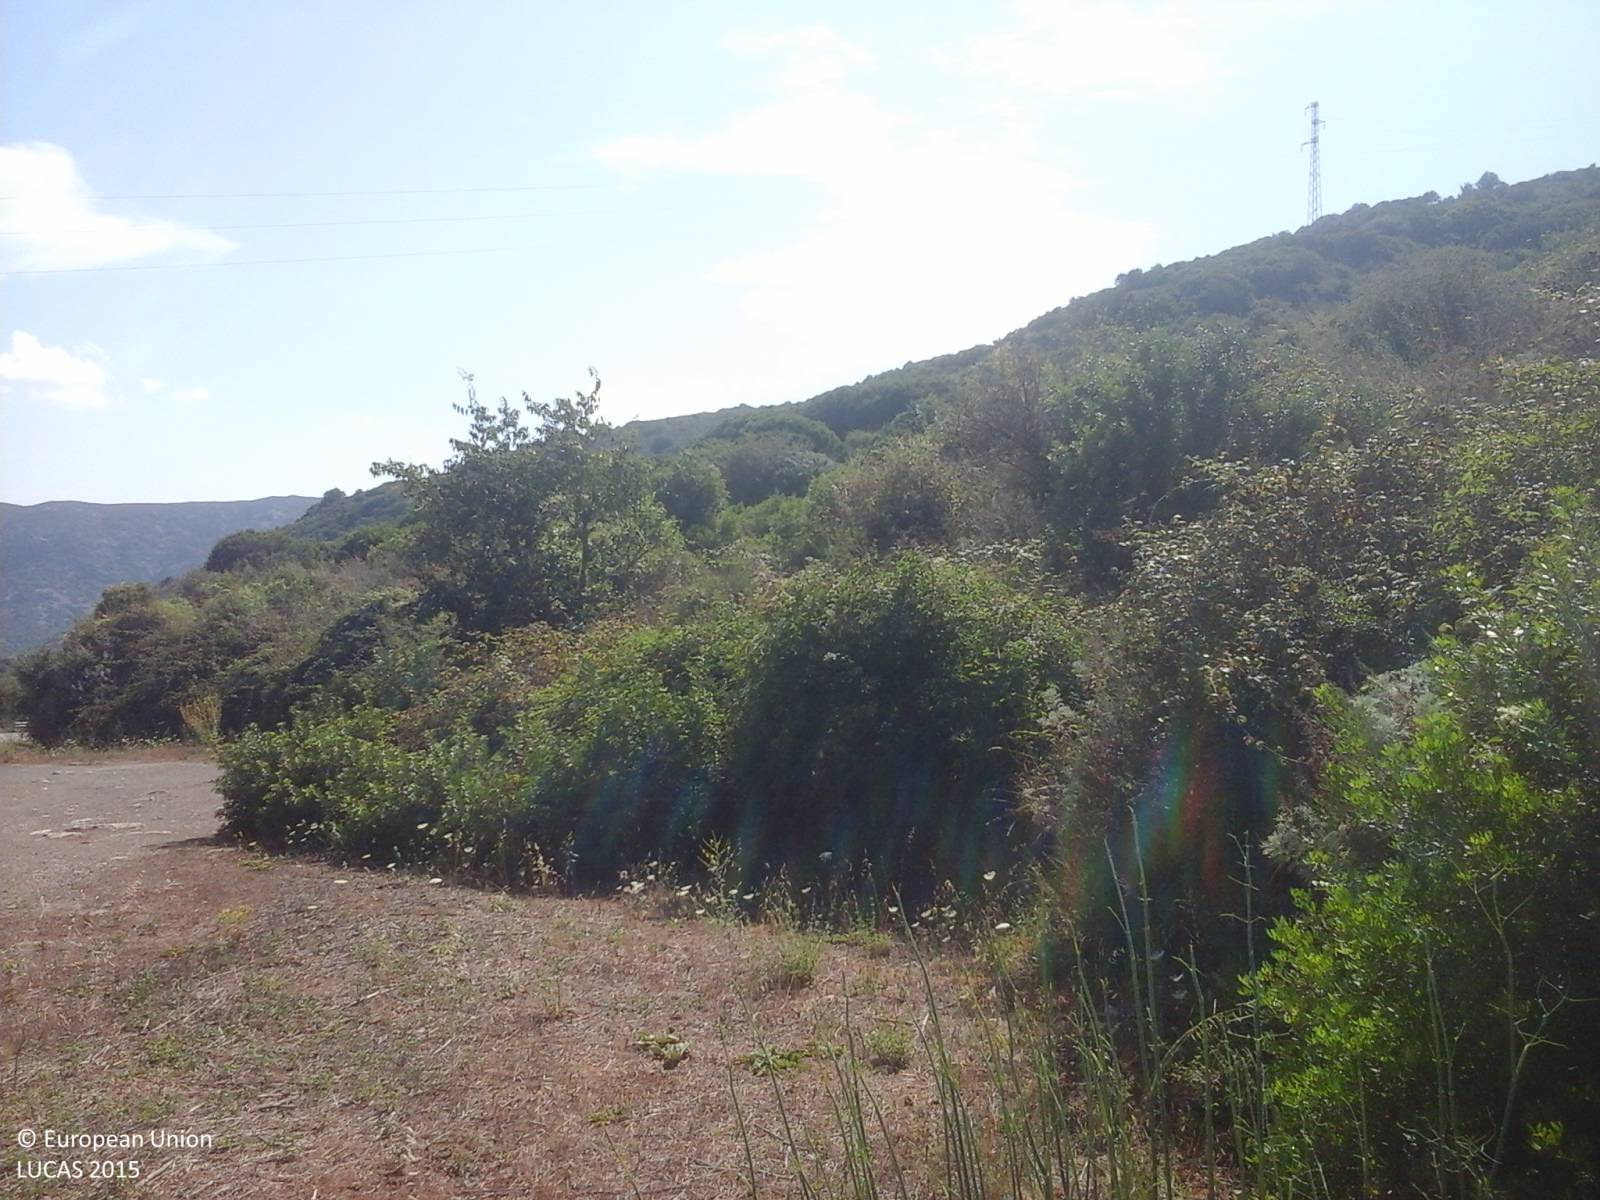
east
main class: Shrubland
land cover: Shrubland without tree cover
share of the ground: > 75 %
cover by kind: unconsolidated bare surface 55 %, shrubs 45 %
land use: Agriculture (excluding fallow land and kitchen gardens)
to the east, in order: Shrubland without tree cover; Shrubland with sparse tree cover; Dry stone walls; Shrubland with sparse tree cover; Dry stone walls; Broadleaved woodland; Electric lines; Broadleaved woodland
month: July
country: IT
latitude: 39.5229
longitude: 9.3871
